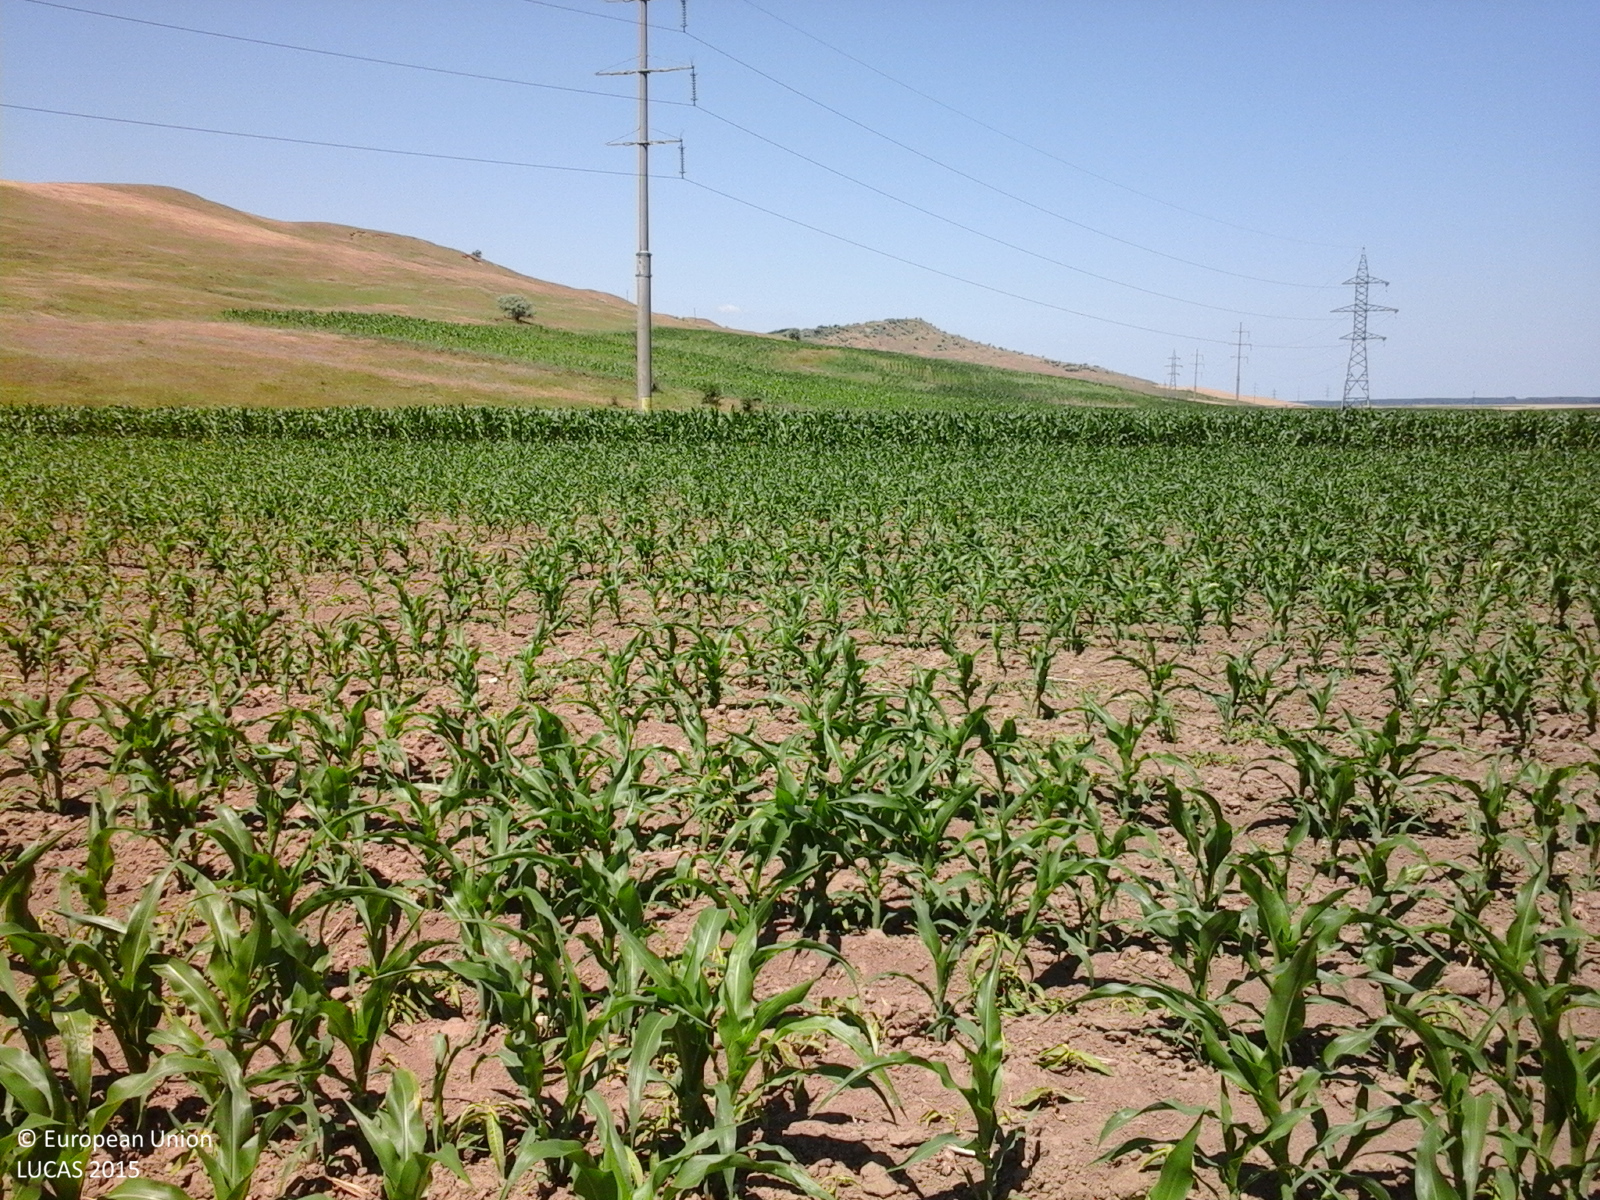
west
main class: Cropland
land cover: Maize
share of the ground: 25 - 50 %
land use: Agriculture (excluding fallow land and kitchen gardens)
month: June
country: RO
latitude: 46.9881
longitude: 27.9716
